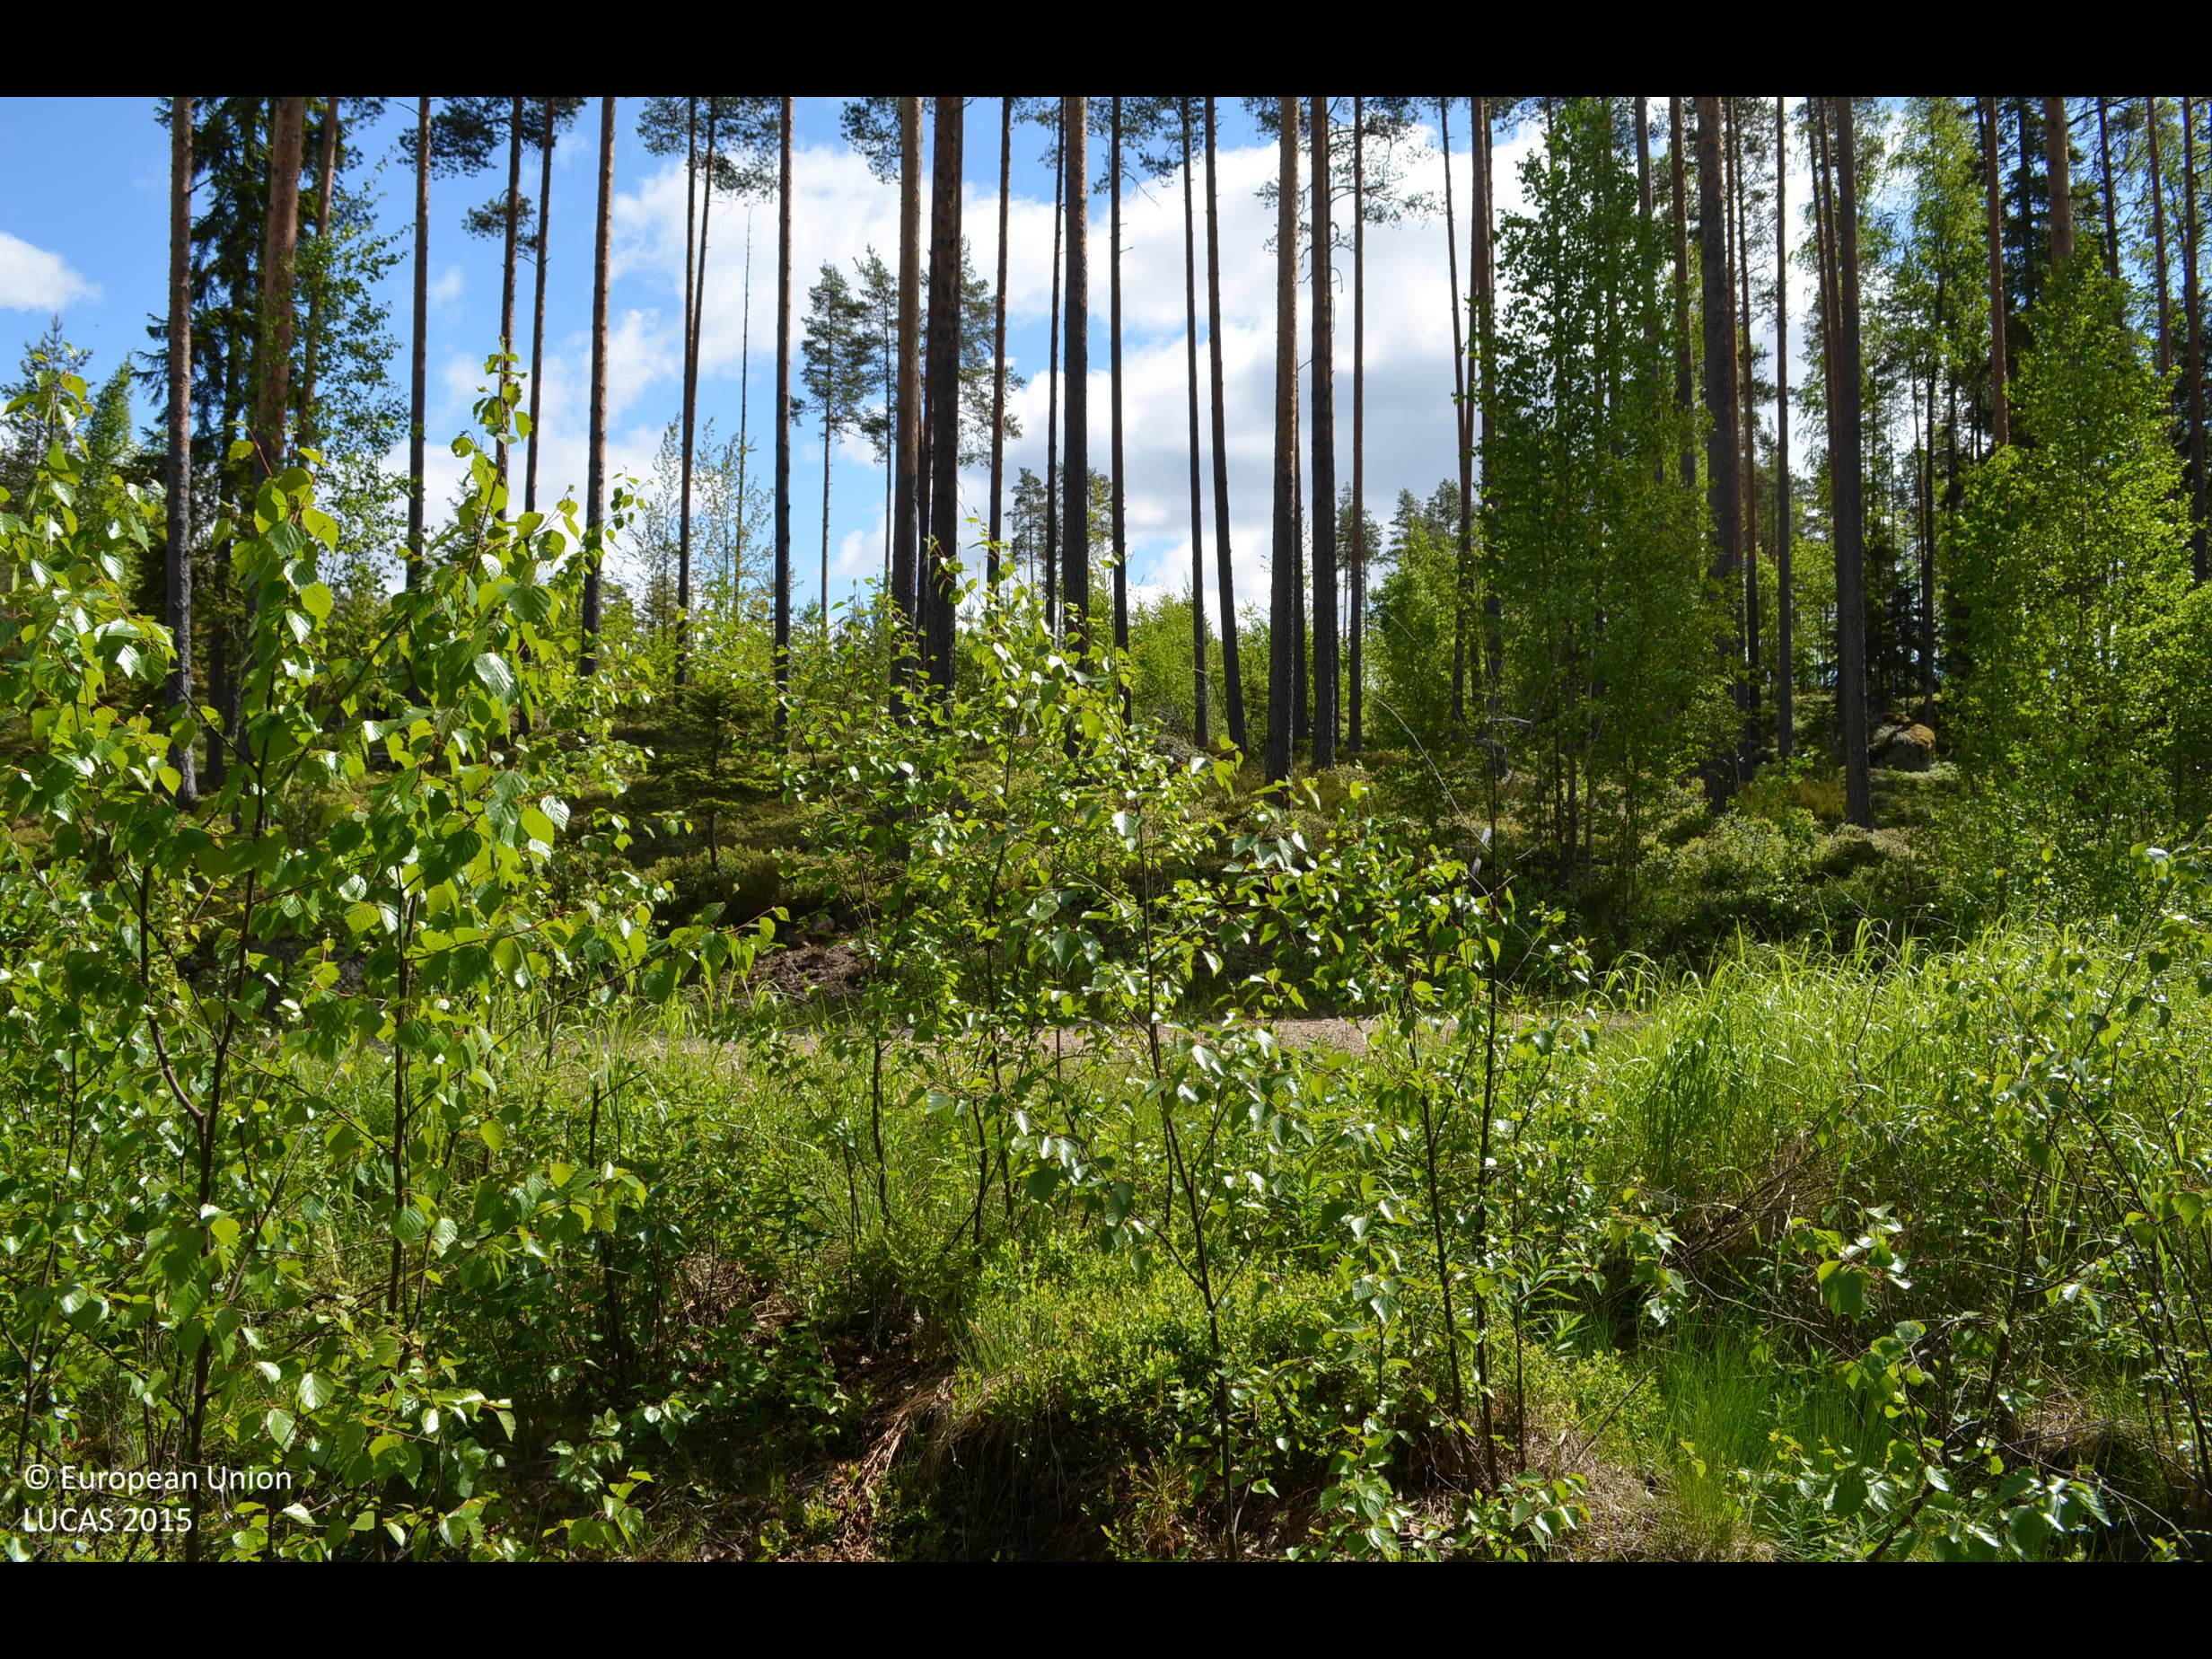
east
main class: Woodland
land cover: Pine dominated mixed woodland
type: boreal forest
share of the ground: 50 - 75 %
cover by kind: coniferous forest trees 50 %, shrubs 30 %, broadleaved forest trees 20 %
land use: Forestry
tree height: > 5 m
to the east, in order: Pine dominated mixed woodland; Ditches and canals; Abandoned hedges; Tracks; Ditches and canals; Pine dominated coniferous woodland; Other mixed woodland; Shrubland without tree cover; Other mixed woodland; Spruce dominated coniferous woodland
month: June
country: FI
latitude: 61.8339
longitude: 23.1168
